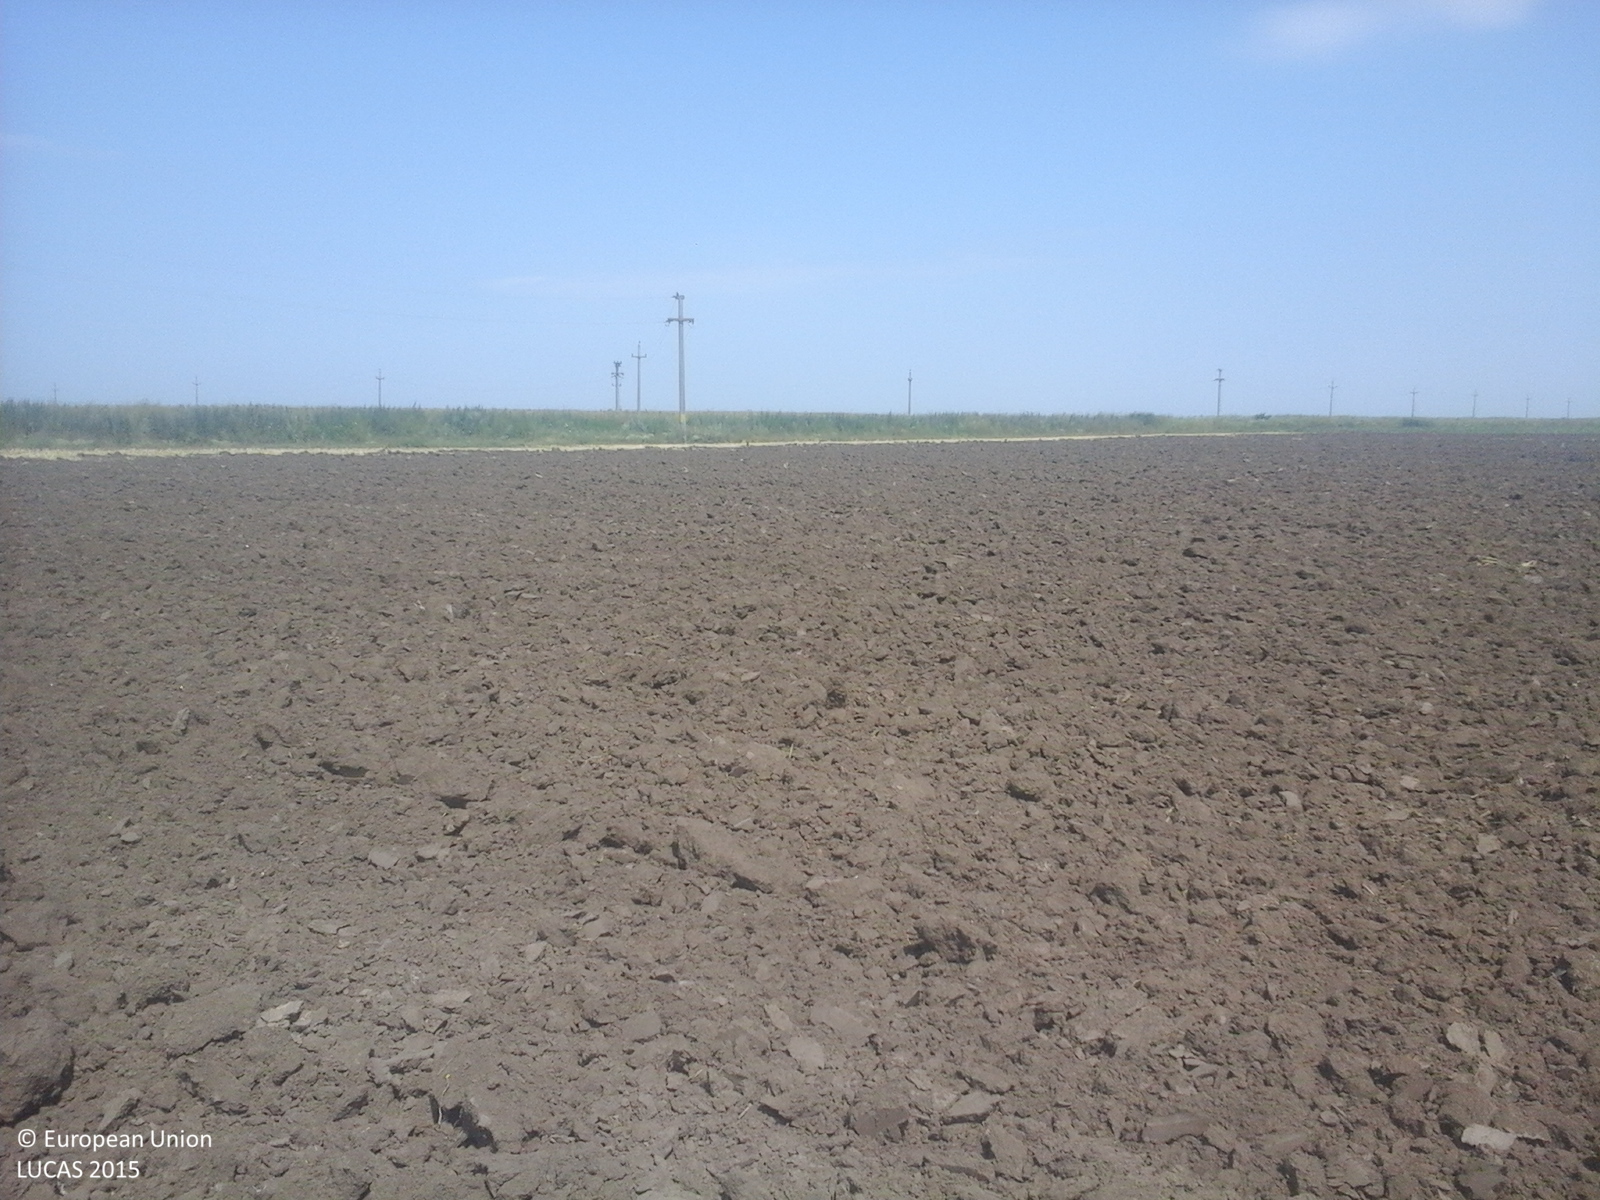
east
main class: Cropland
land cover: Common wheat
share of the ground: < 10 %
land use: Agriculture (excluding fallow land and kitchen gardens)
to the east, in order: Common wheat; Shruby margins; Tracks; Shruby margins; Electric lines; Shruby margins; Inland fresh running water; Spontaneously vegetated surfaces; Tracks; Soya; Spontaneously vegetated surfaces
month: July
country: RO
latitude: 44.9848
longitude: 27.6155
